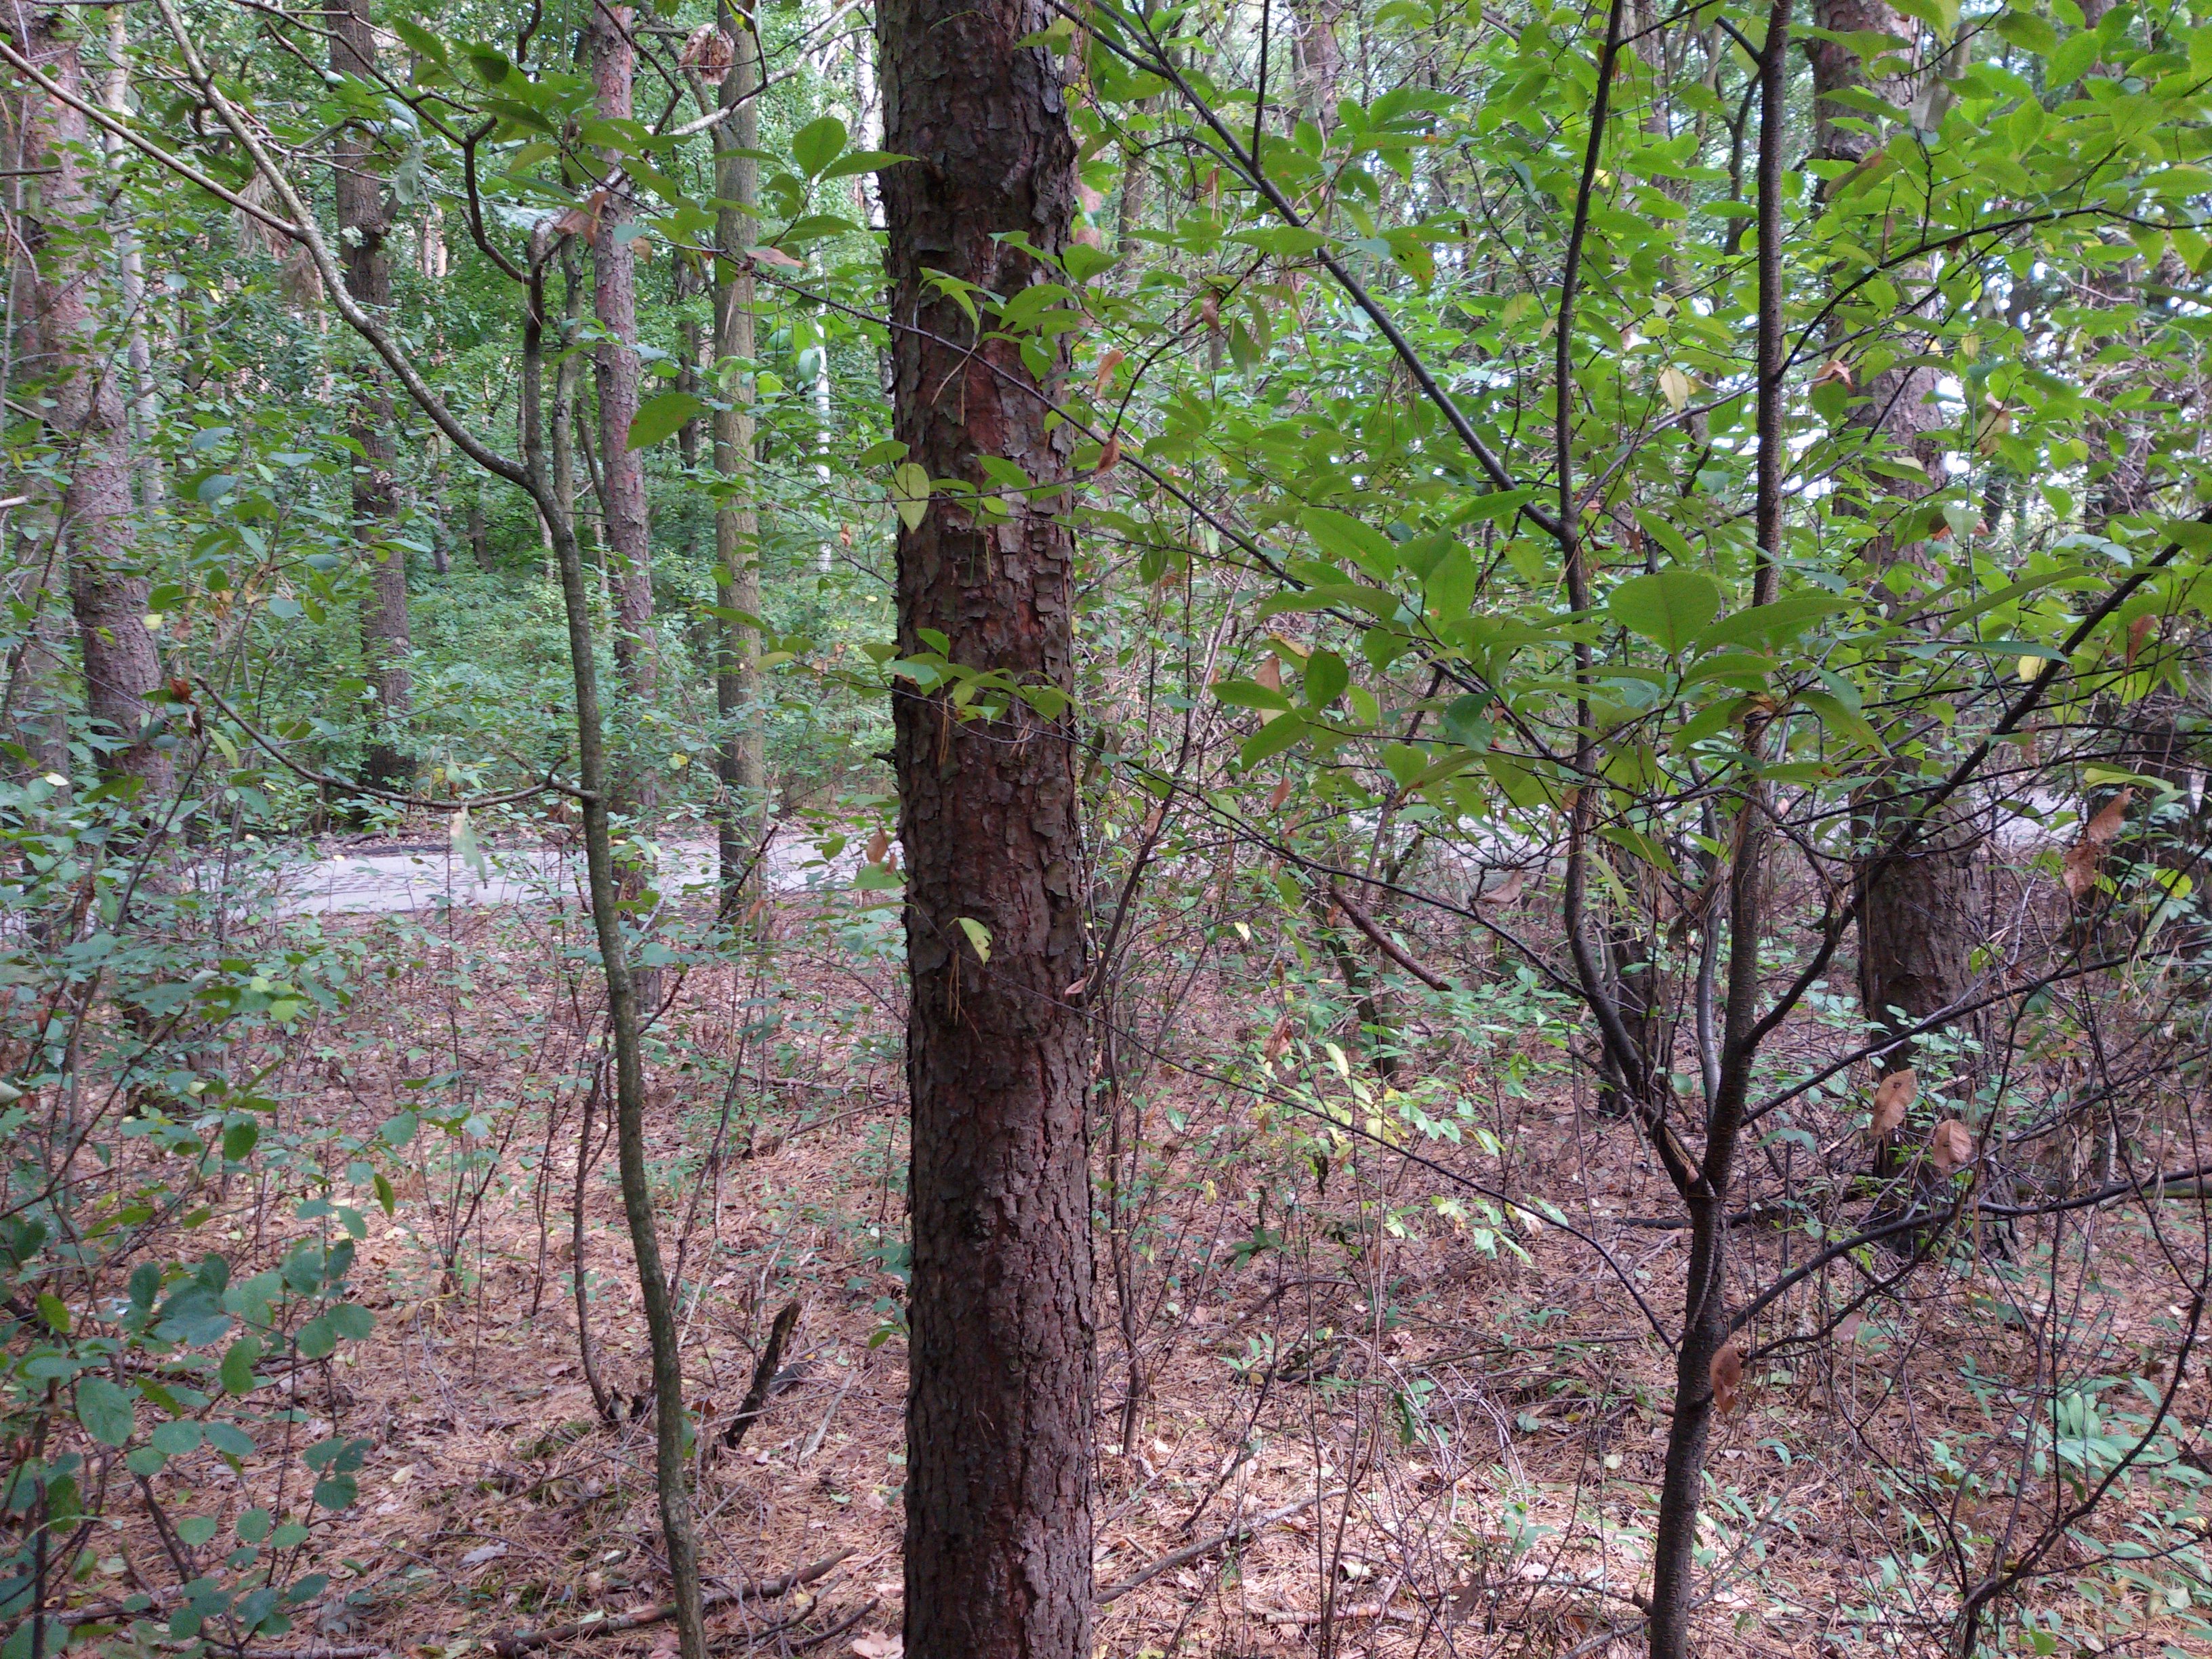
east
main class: Woodland
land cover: Pine dominated mixed woodland
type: hemiboreal forest and nemoral coniferous forest and mixed broadleaved-coniferous forest
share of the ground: > 75 %
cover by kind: coniferous forest trees 60 %, broadleaved forest trees 25 %, shrubs 10 %, unconsolidated bare surface 5 %
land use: Forestry
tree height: > 5 m
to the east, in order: Pine dominated mixed woodland; Paved roads, cycling and walking lanes; Pine dominated mixed woodland; Artificial constructions in urban areas
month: September
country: PL
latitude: 53.1219
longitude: 17.6787
